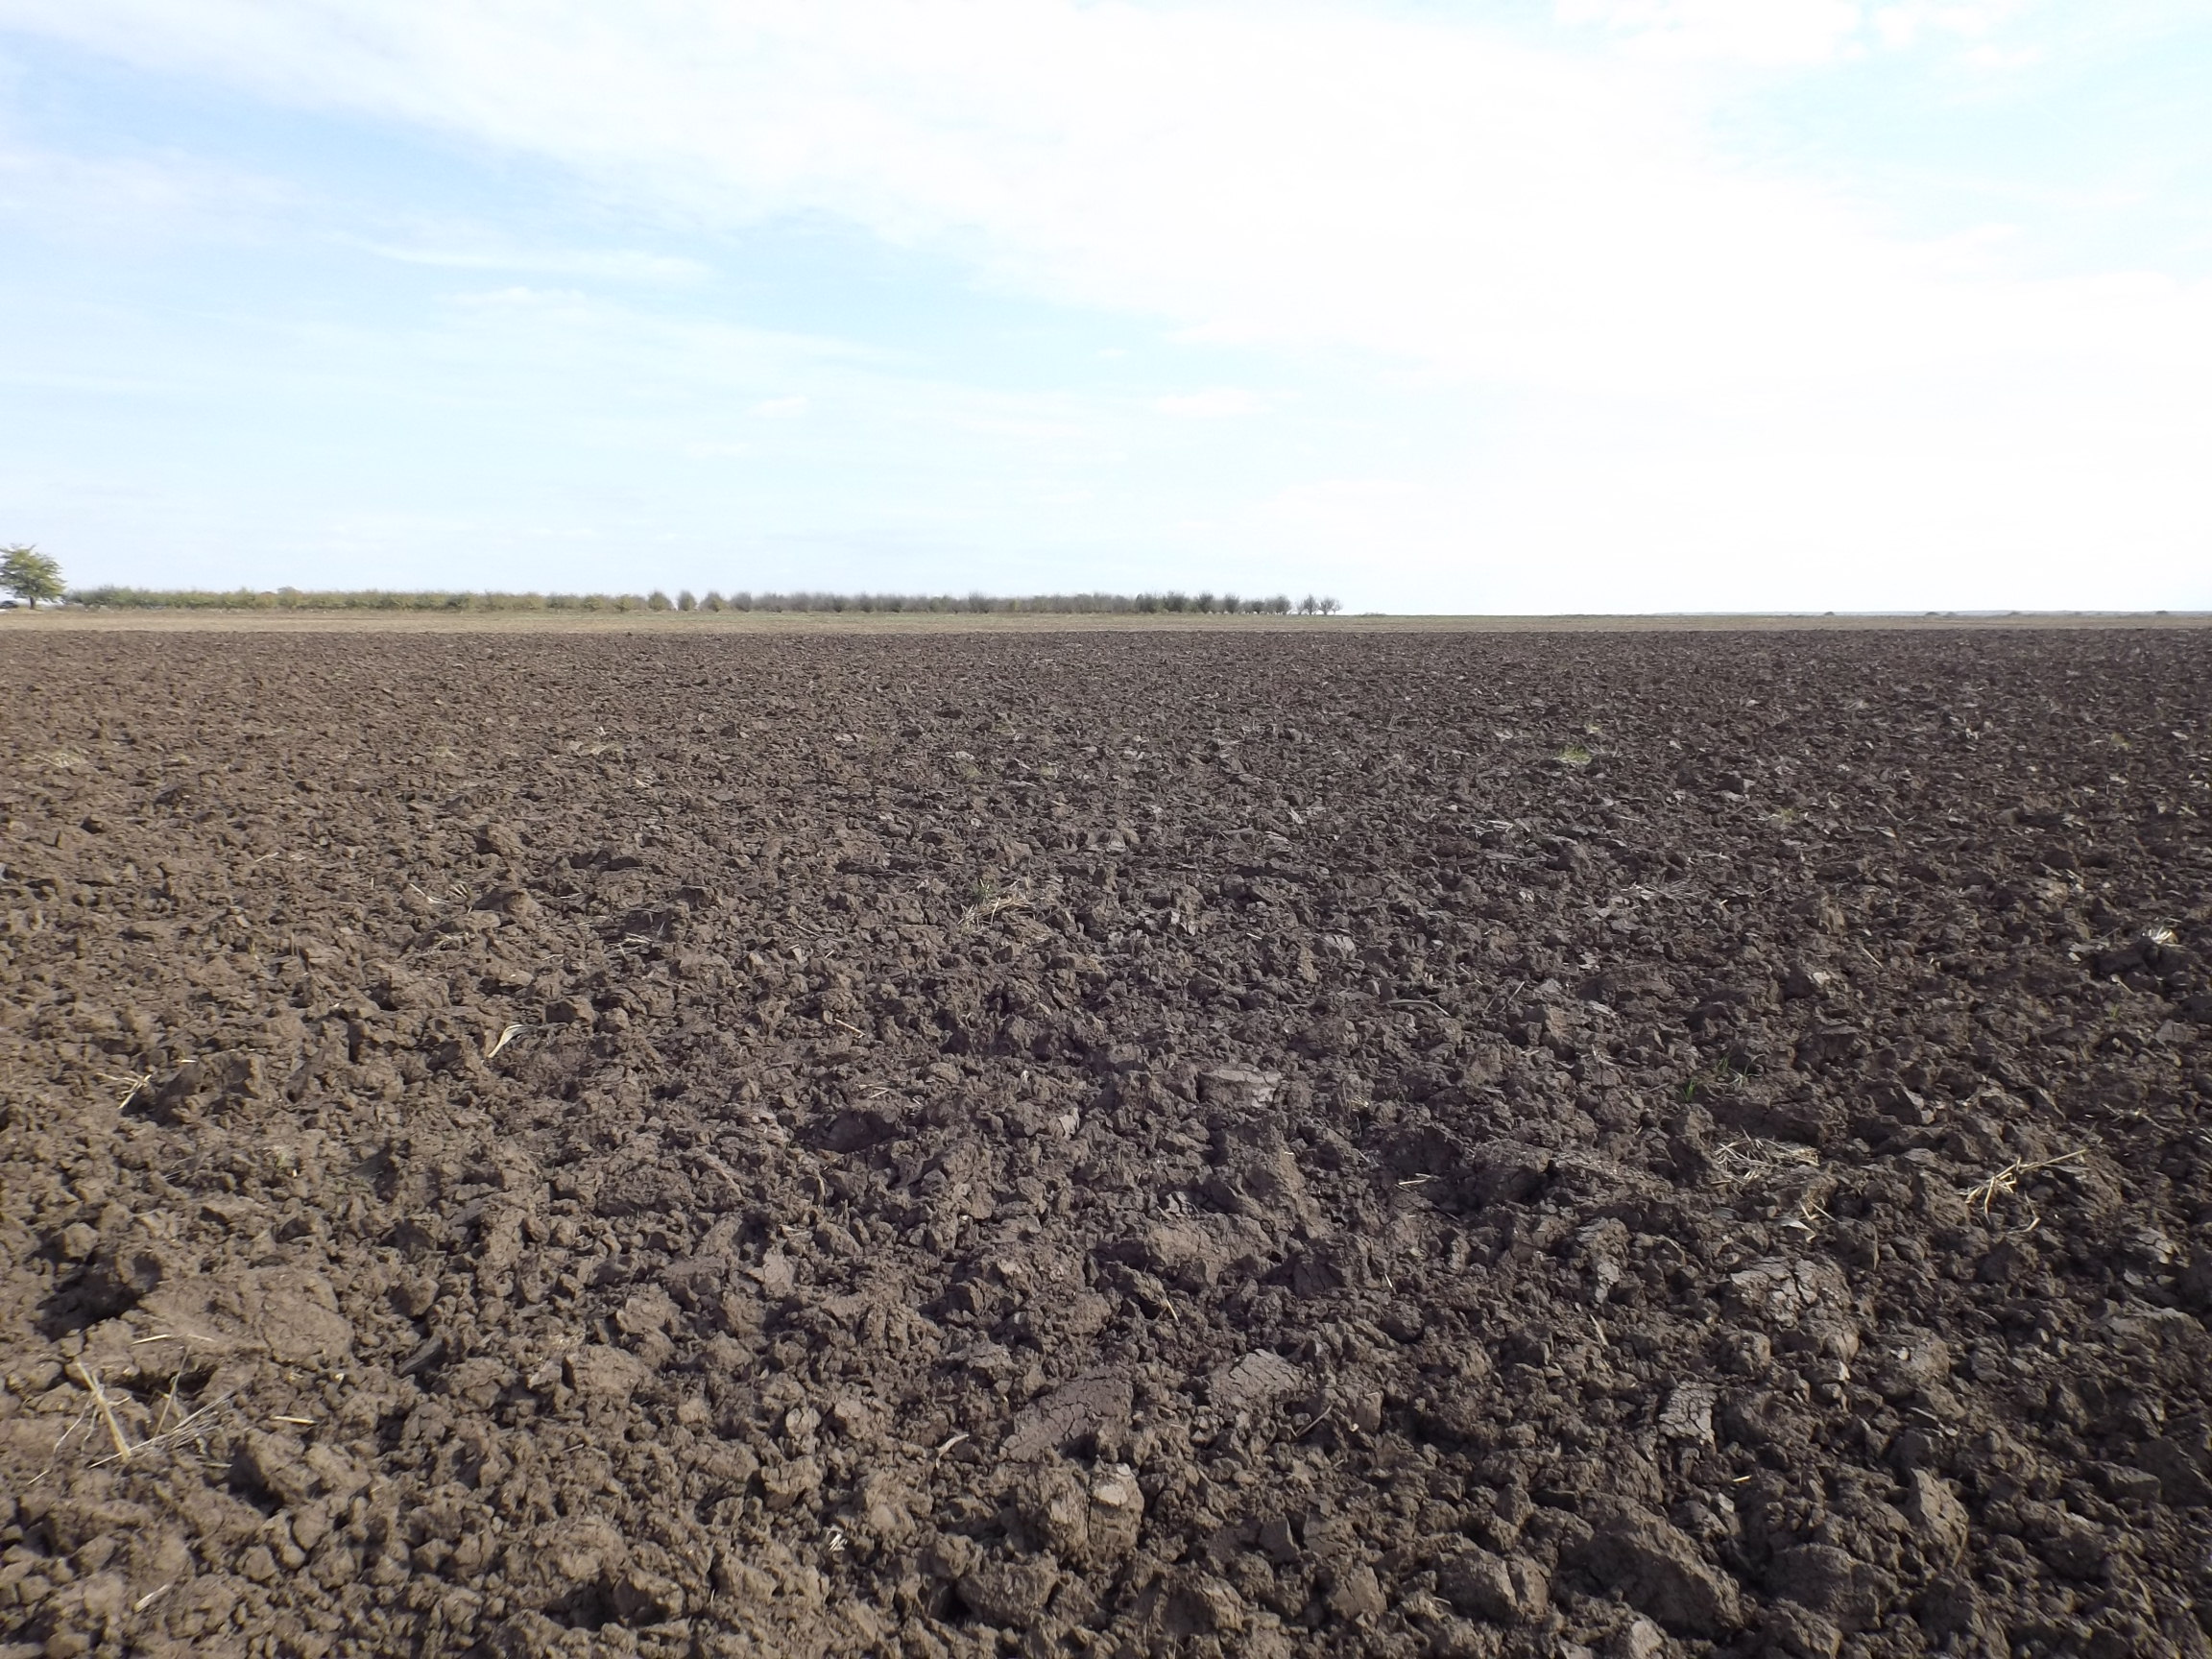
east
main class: Cropland
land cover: Common wheat
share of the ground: < 10 %
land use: Agriculture (excluding fallow land and kitchen gardens)
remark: Harvested field
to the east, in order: Common wheat; Oats; Sunflower
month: October
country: BG
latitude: 43.9046
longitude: 26.8140
